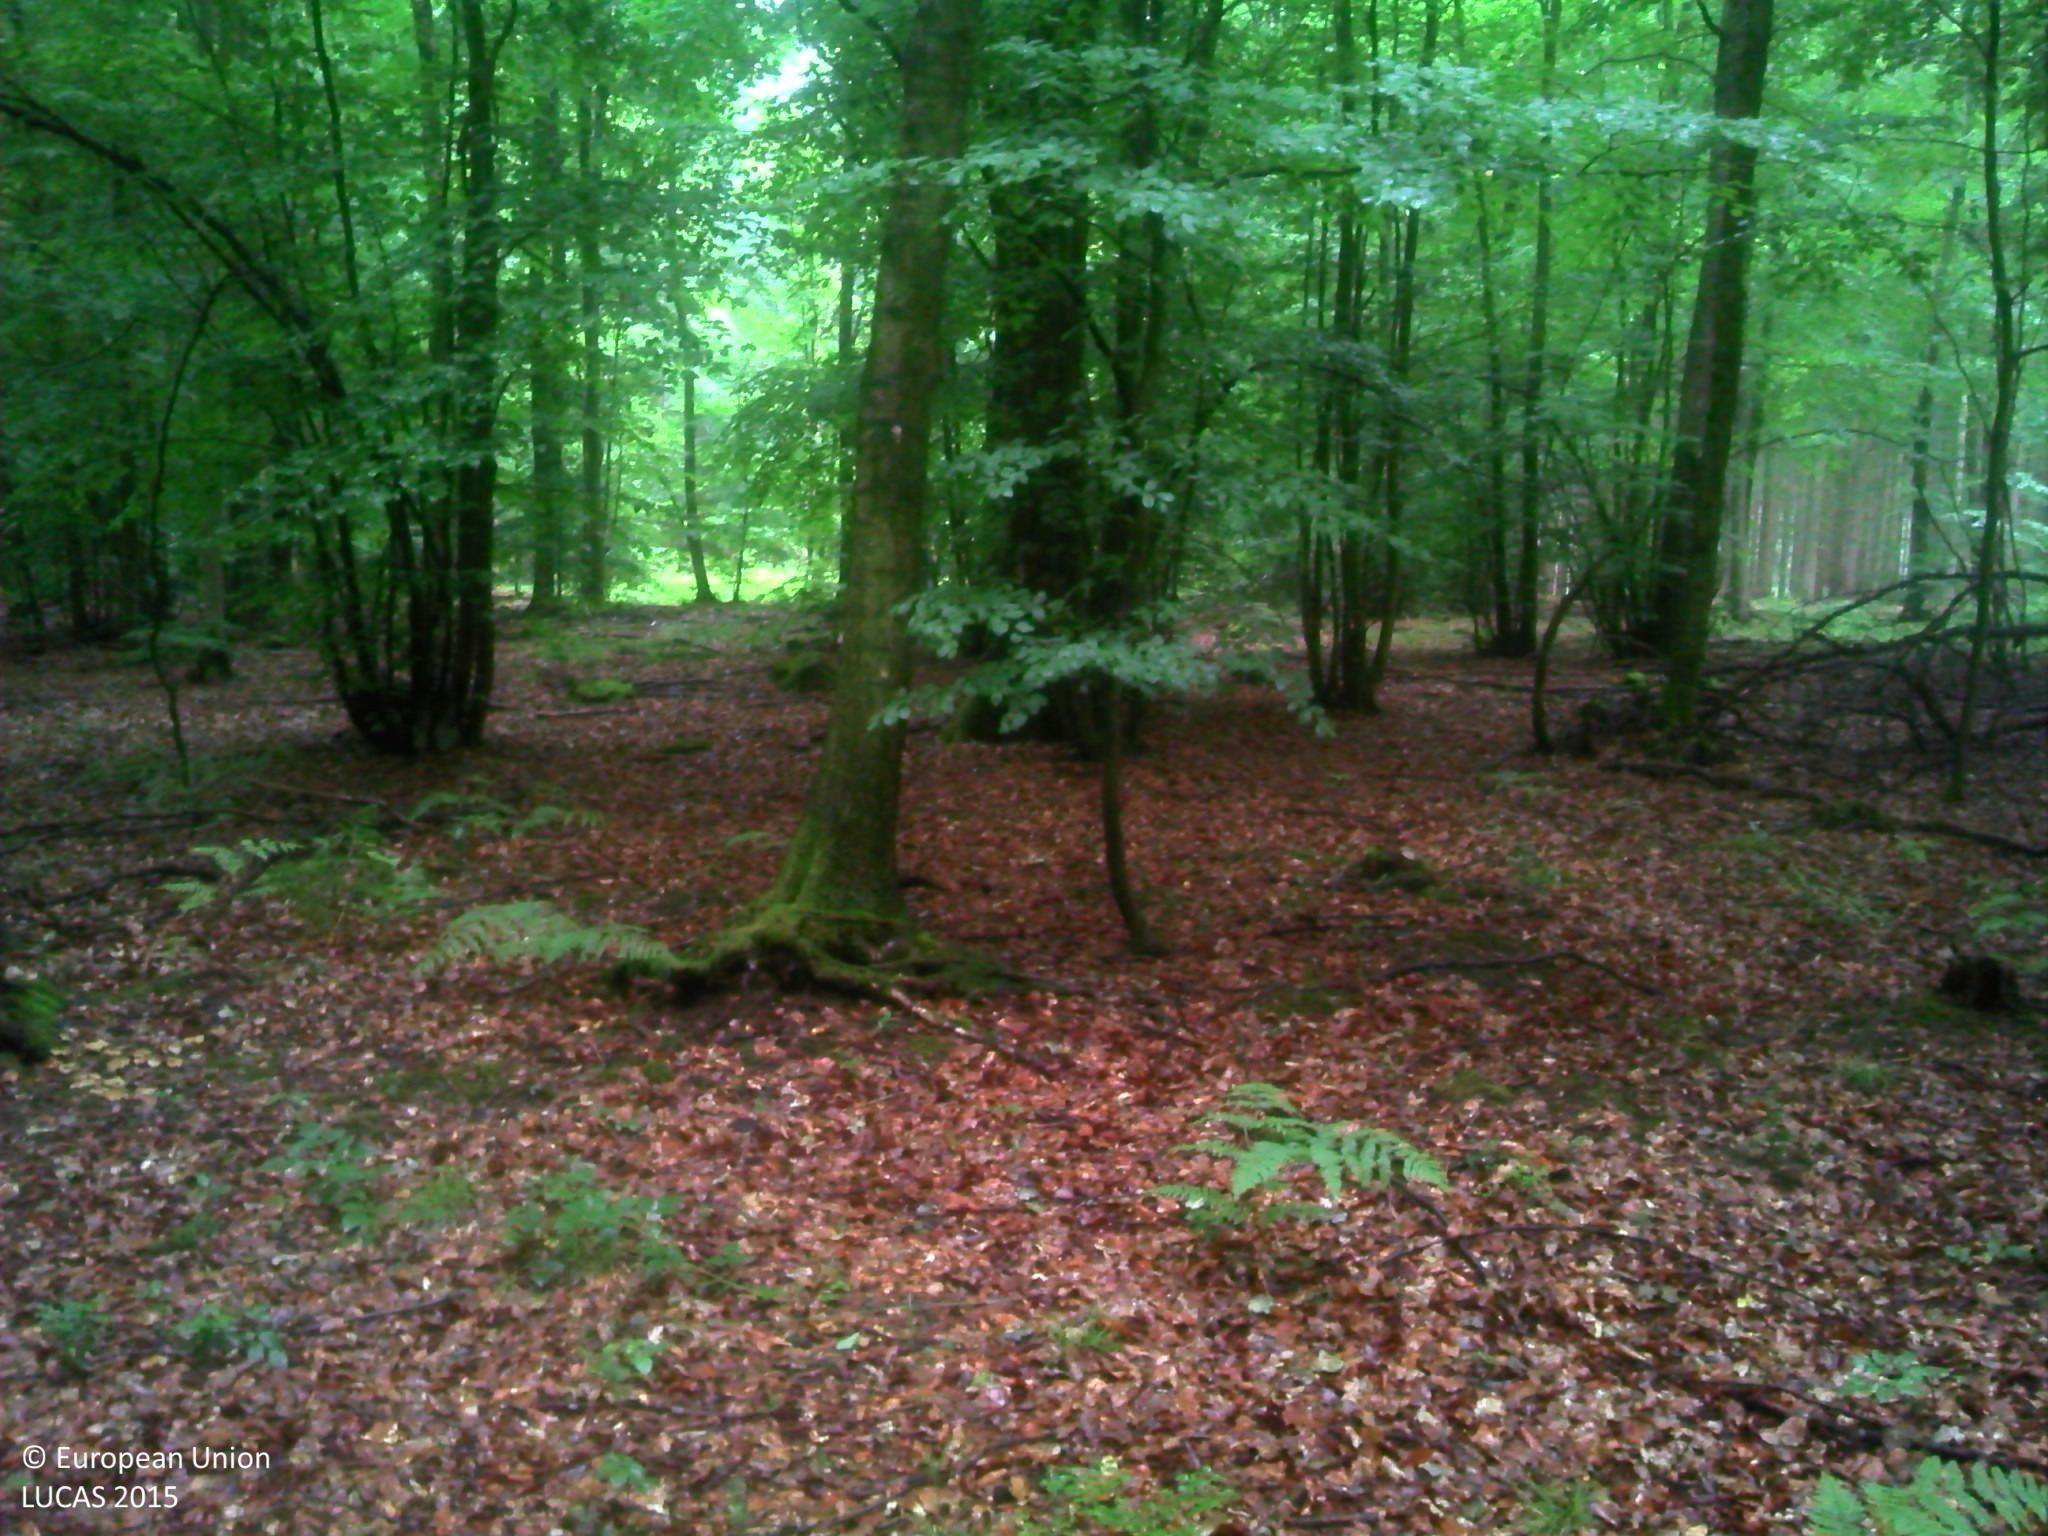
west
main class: Woodland
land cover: Broadleaved woodland
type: acidophilous oak and oak-birch forest
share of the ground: > 75 %
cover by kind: broadleaved forest trees 100 %
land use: Forestry
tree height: > 5 m
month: July
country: BE
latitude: 50.0419
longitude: 4.6765
